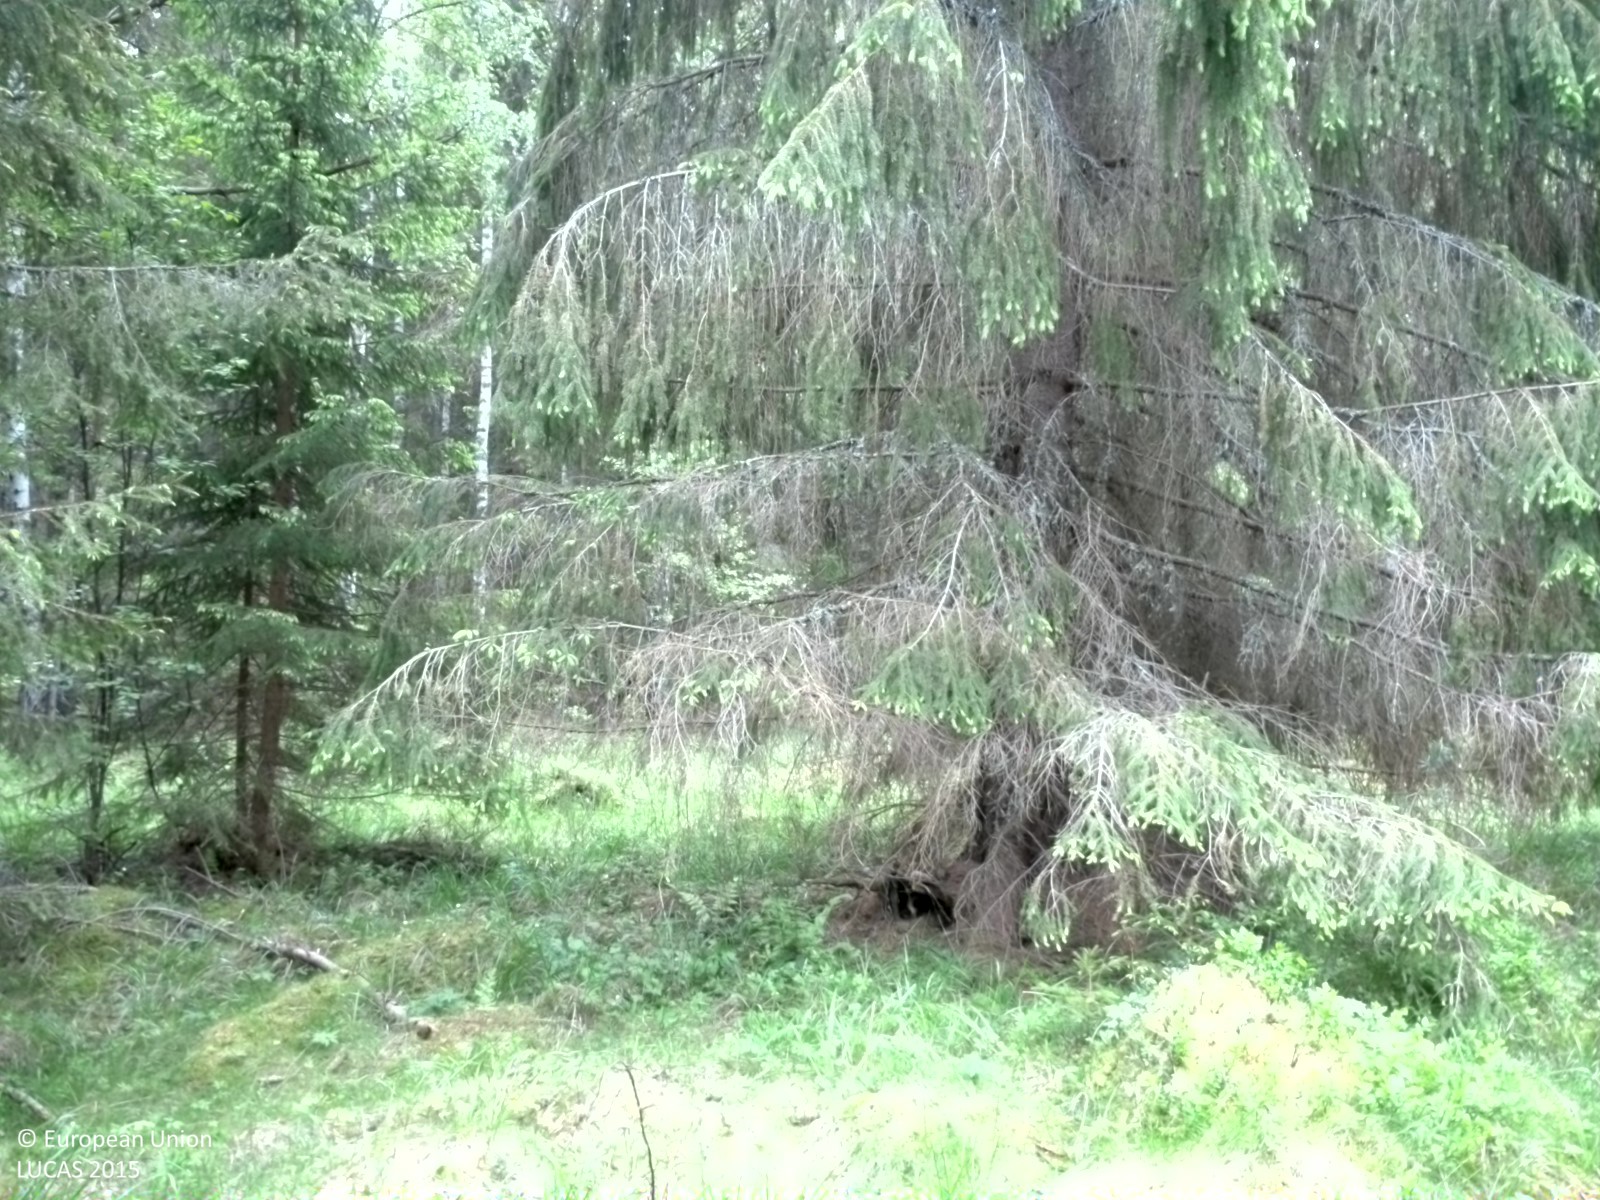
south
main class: Woodland
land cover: Spruce dominated coniferous woodland
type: boreal forest
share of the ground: 50 - 75 %
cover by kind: coniferous forest trees 45 %, herbaceous plants 20 %, broadleaved forest trees 15 %, shrubs 5 %, lichens and mosses 5 %
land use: Forestry
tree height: > 5 m
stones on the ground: 10 - 25 %
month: June
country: SE
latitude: 60.2912
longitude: 17.0998
